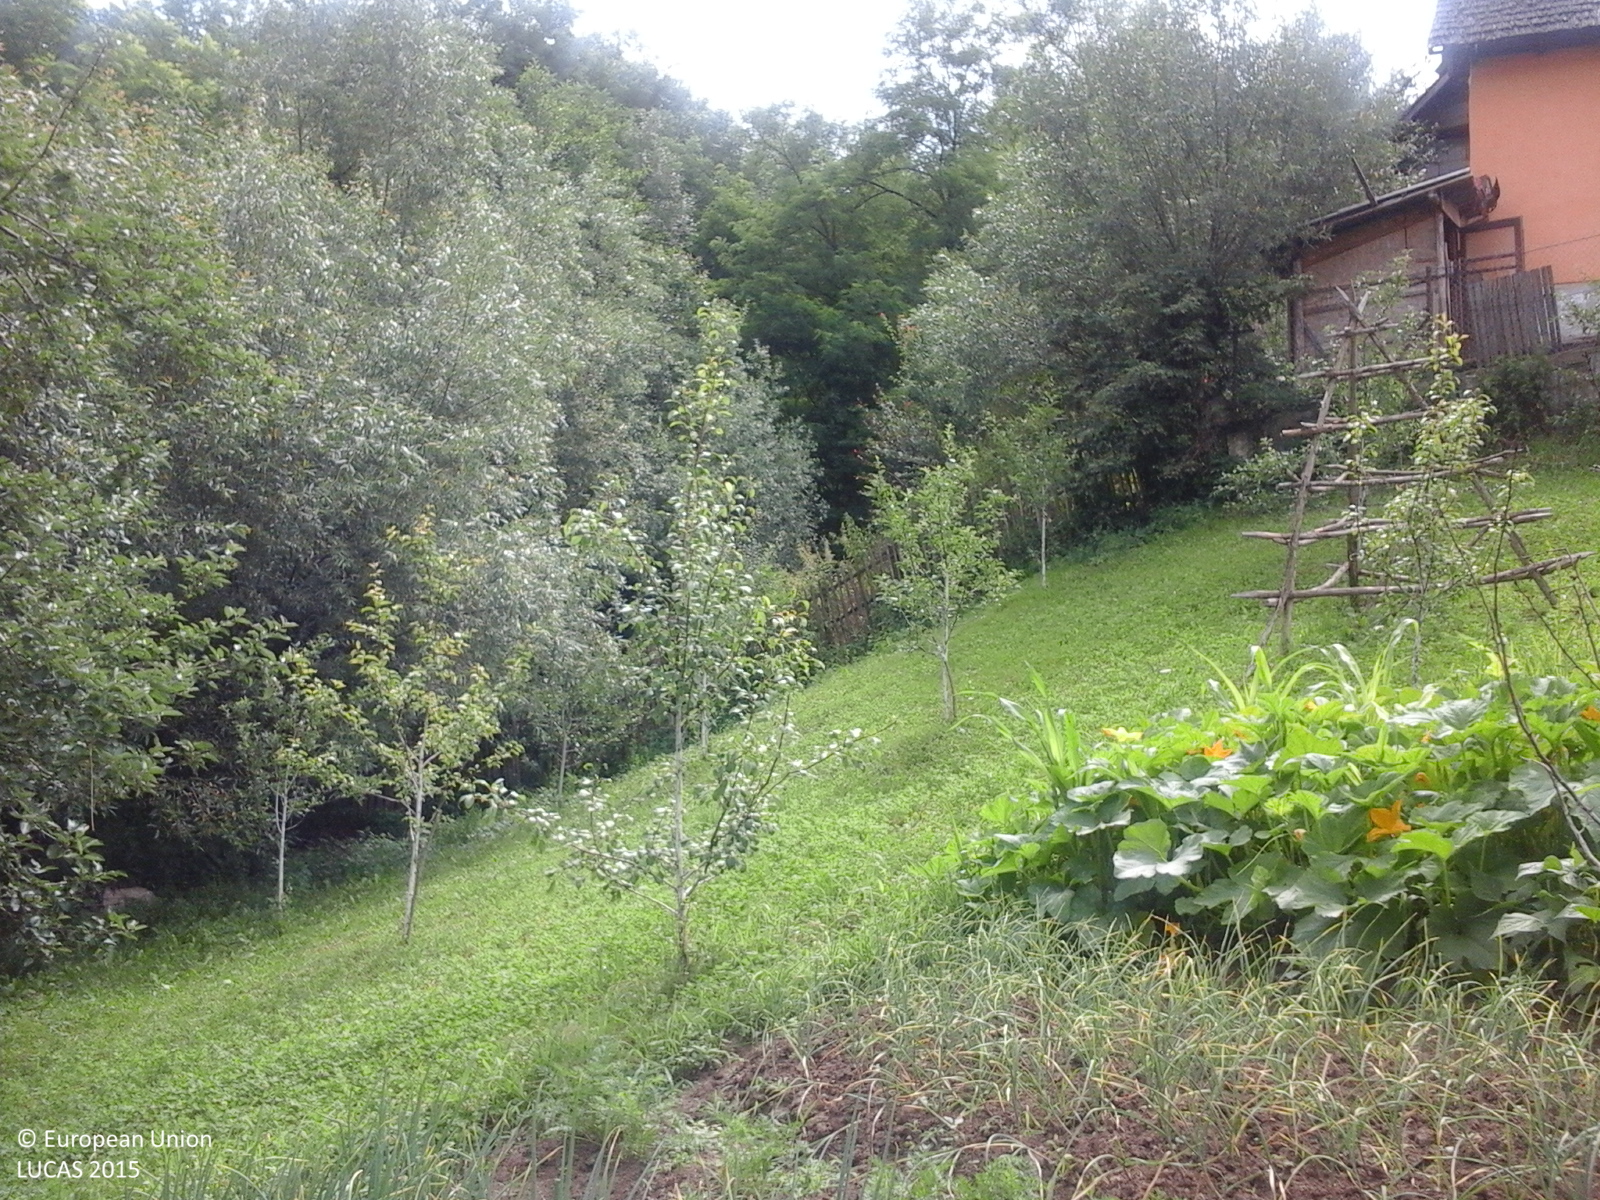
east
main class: Cropland
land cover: Apple fruit
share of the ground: > 75 %
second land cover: Grassland without tree/shrub cover
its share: > 75 %
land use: Agriculture (excluding fallow land and kitchen gardens)
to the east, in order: Apple fruit; Grassland without tree/shrub cover; Arable land (only in case pi); Broadleaved woodland; Arable land (only in case pi); Broadleaved woodland; Arable land (only in case pi); Broadleaved woodland; Permanent crops (only in case pi)
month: July
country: RO
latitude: 45.1995
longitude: 24.7081
